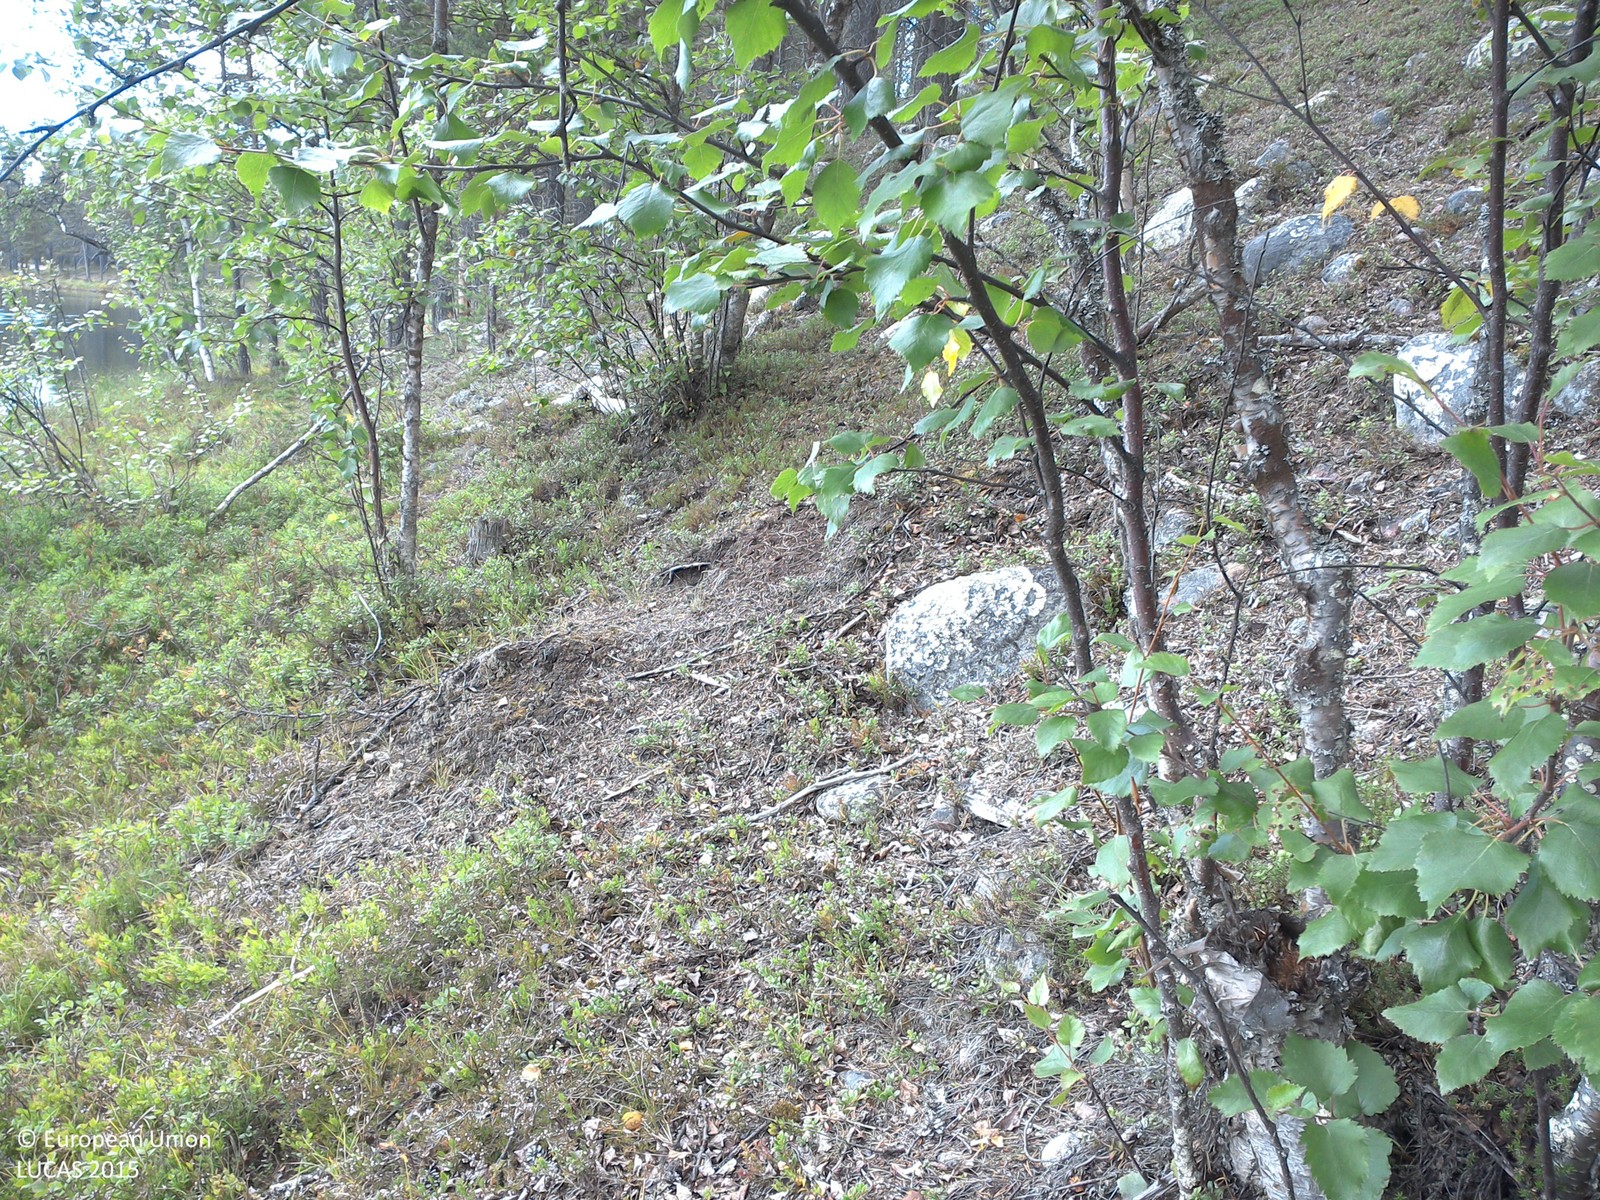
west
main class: Woodland
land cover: Pine dominated coniferous woodland
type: boreal forest
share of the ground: 25 - 50 %
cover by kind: shrubs 60 %, coniferous forest trees 25 %, unconsolidated bare surface 10 %, lichens and mosses 5 %
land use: Forestry
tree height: > 5 m
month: August
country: SE
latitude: 67.4910
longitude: 21.5838
